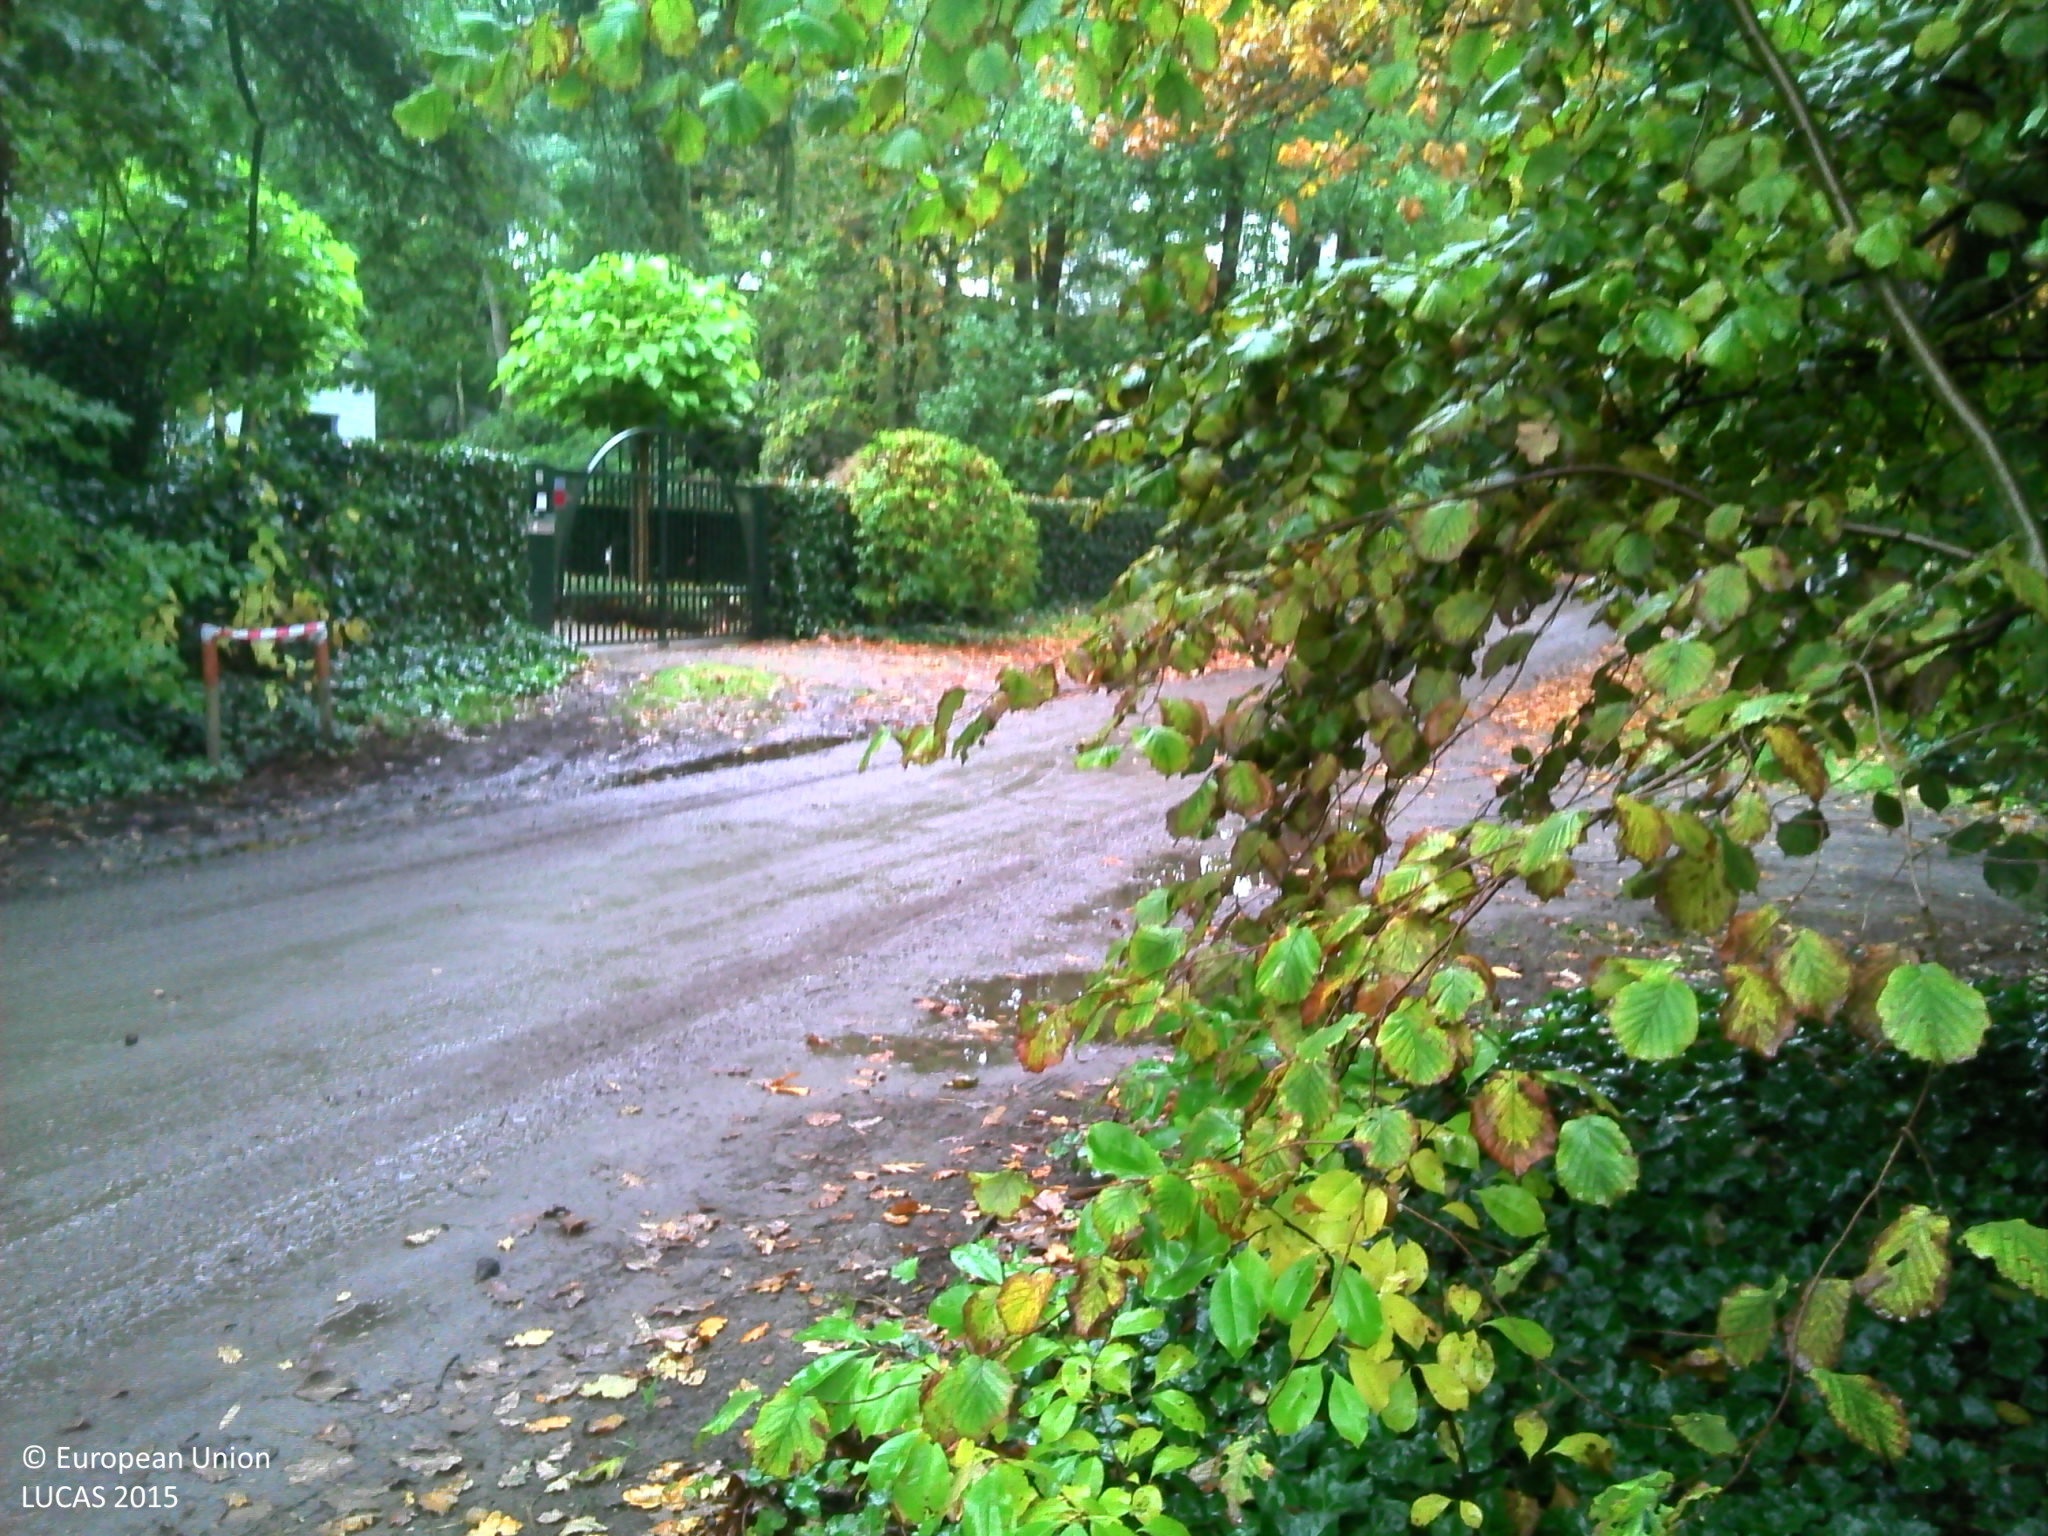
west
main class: Woodland
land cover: Other mixed woodland
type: exotic forest
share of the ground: > 75 %
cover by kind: broadleaved forest trees 70 %, coniferous forest trees 30 %
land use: Residential
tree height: > 5 m
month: October
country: BE
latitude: 50.9972
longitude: 4.6815
